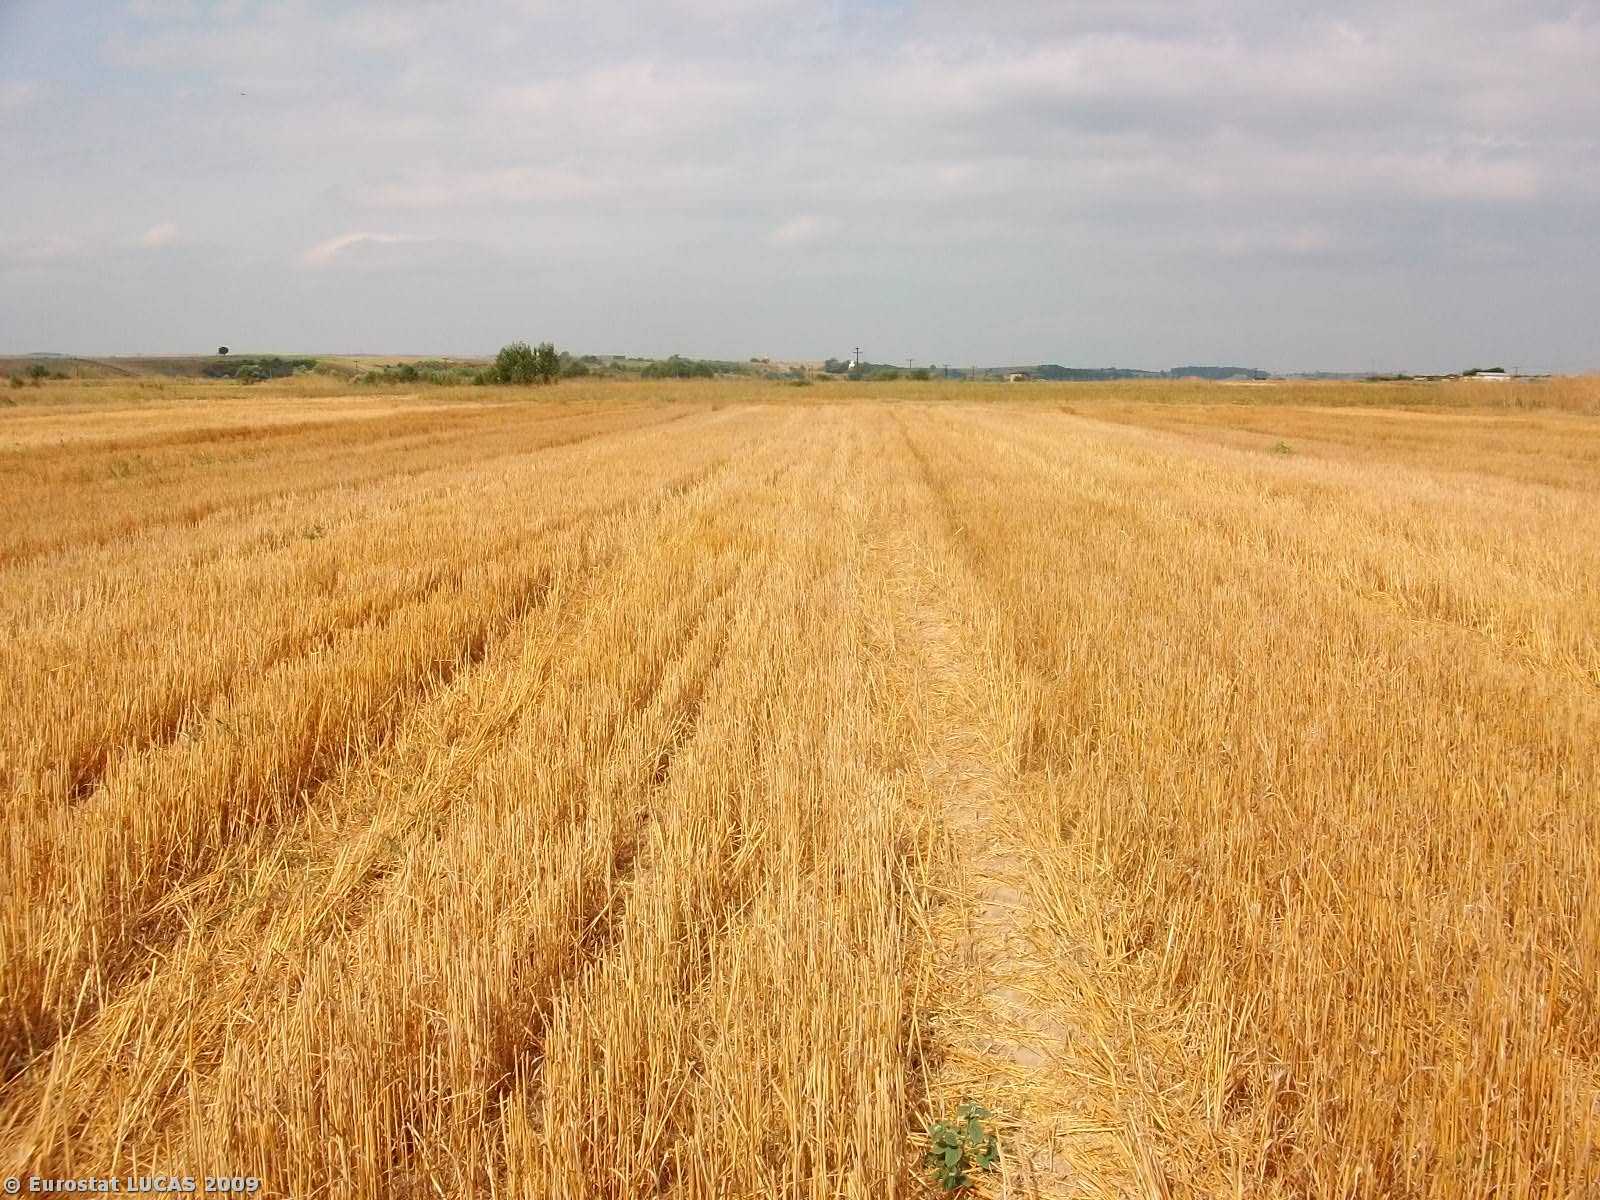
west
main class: Cropland
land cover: Triticale
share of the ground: < 10 %
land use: Agriculture (excluding fallow land and kitchen gardens)
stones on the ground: < 10 %
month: August
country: GR
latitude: 41.4882
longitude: 26.5240
